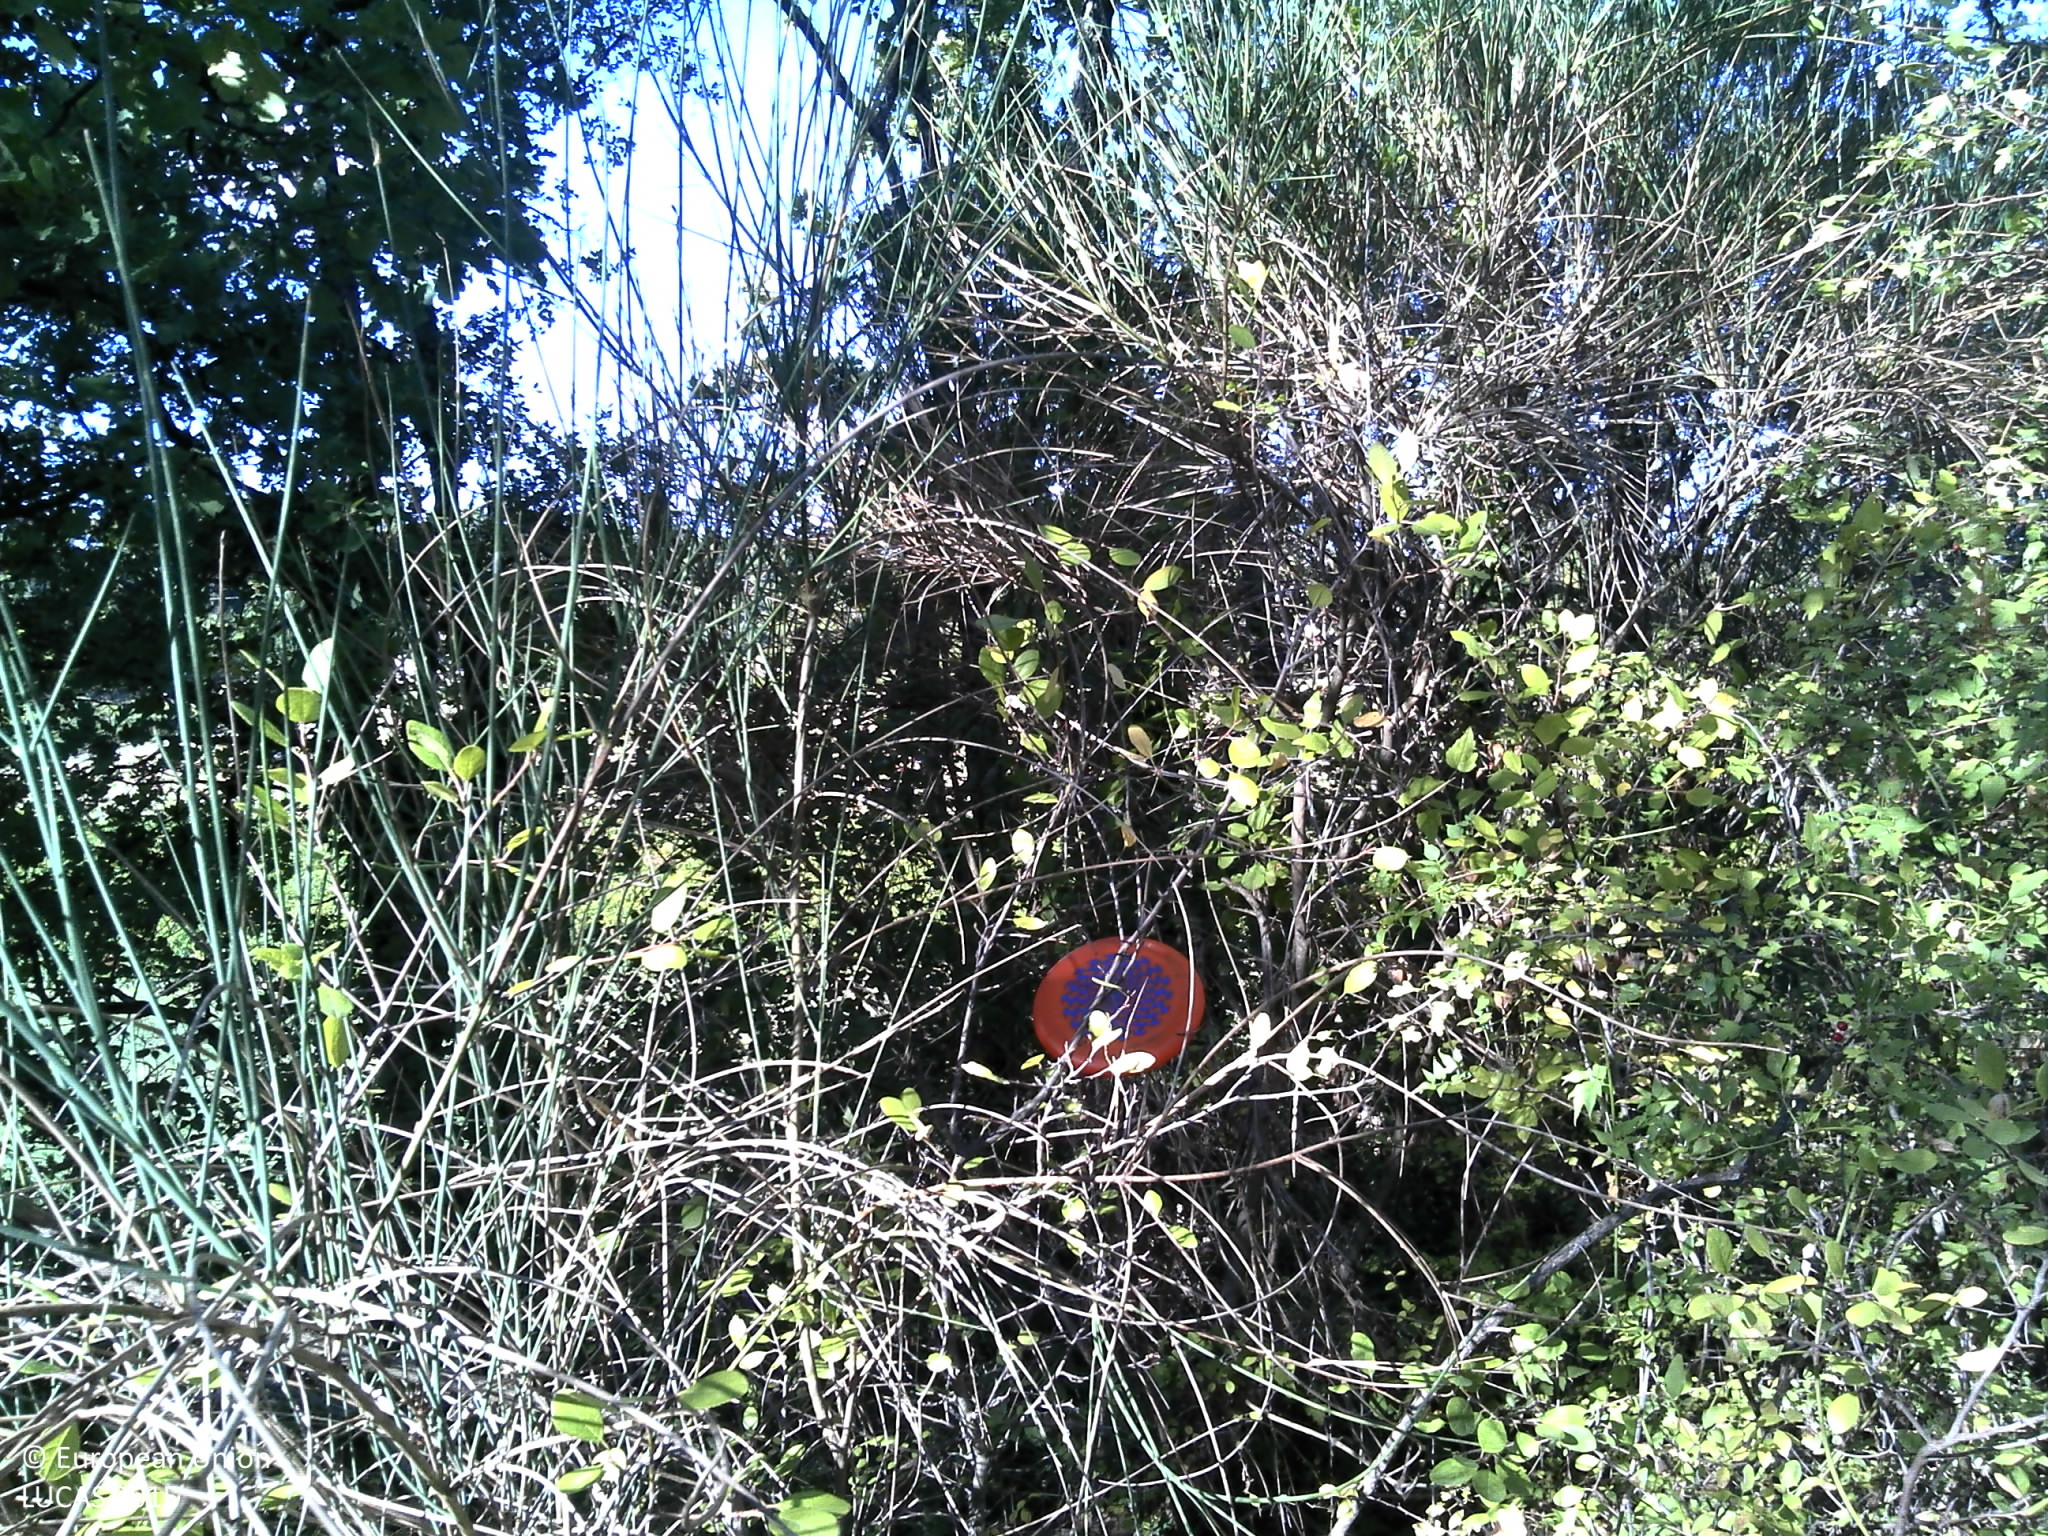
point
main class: Woodland
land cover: Broadleaved woodland
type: thermophilous deciduous forest
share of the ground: 50 - 75 %
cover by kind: broadleaved forest trees 70 %, shrubs 20 %, coniferous forest trees 10 %
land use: Forestry
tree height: > 5 m
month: September
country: FR
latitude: 43.7864
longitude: 5.5726
